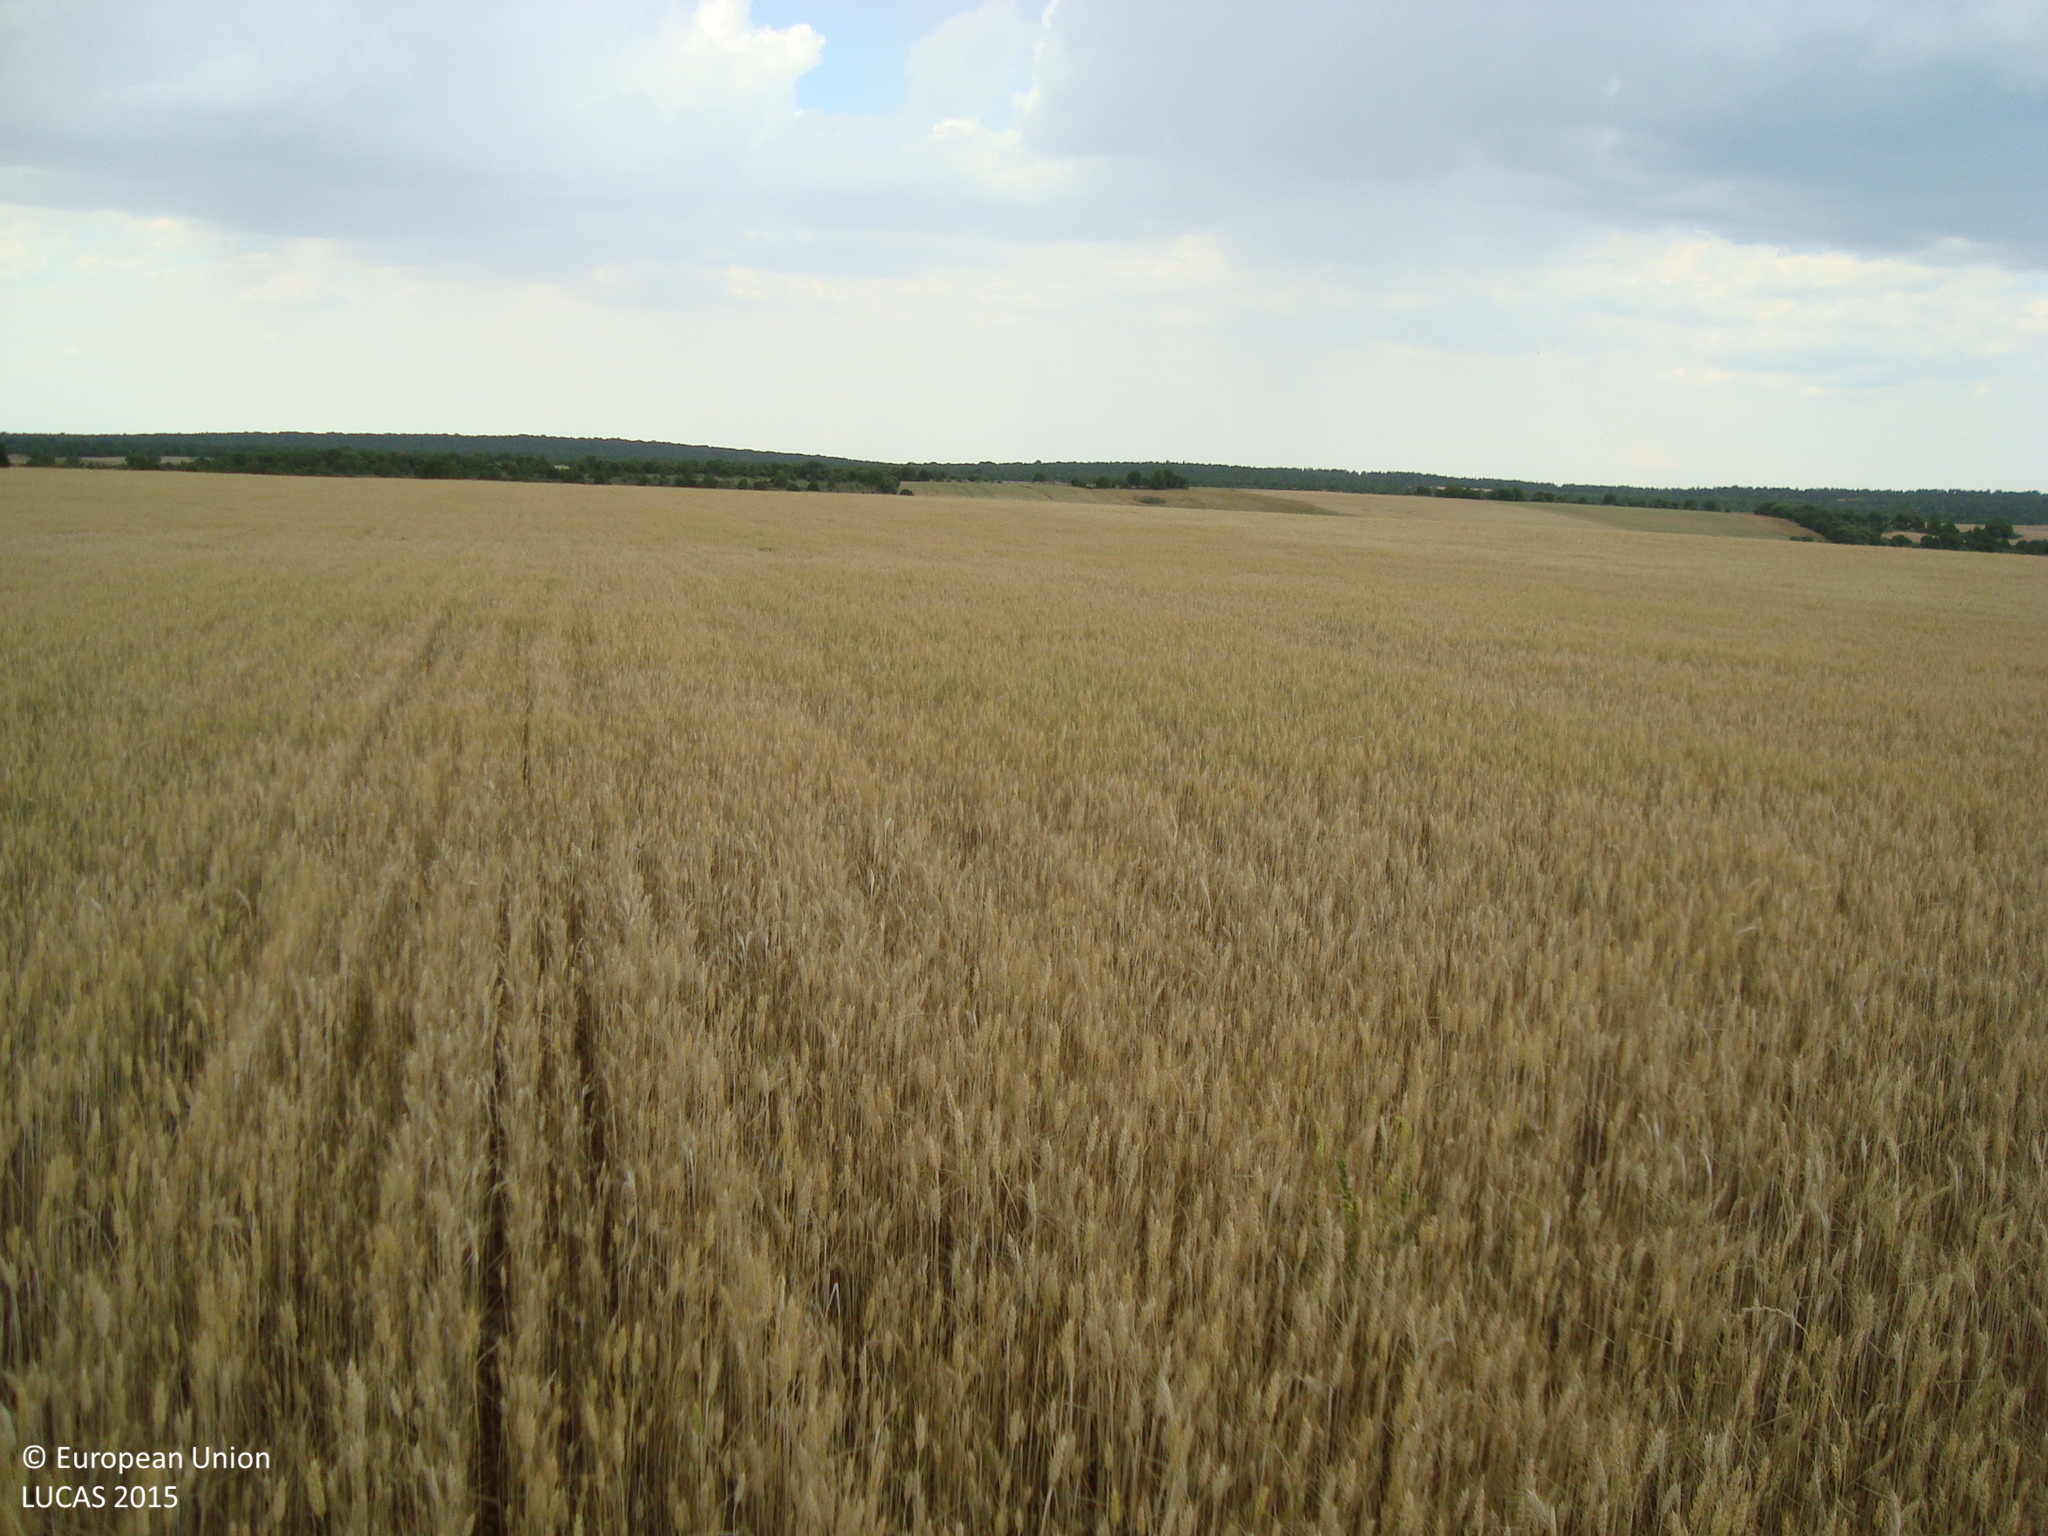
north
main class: Cropland
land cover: Common wheat
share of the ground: > 75 %
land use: Agriculture (excluding fallow land and kitchen gardens)
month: June
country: ES
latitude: 41.9269
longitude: -3.6456
